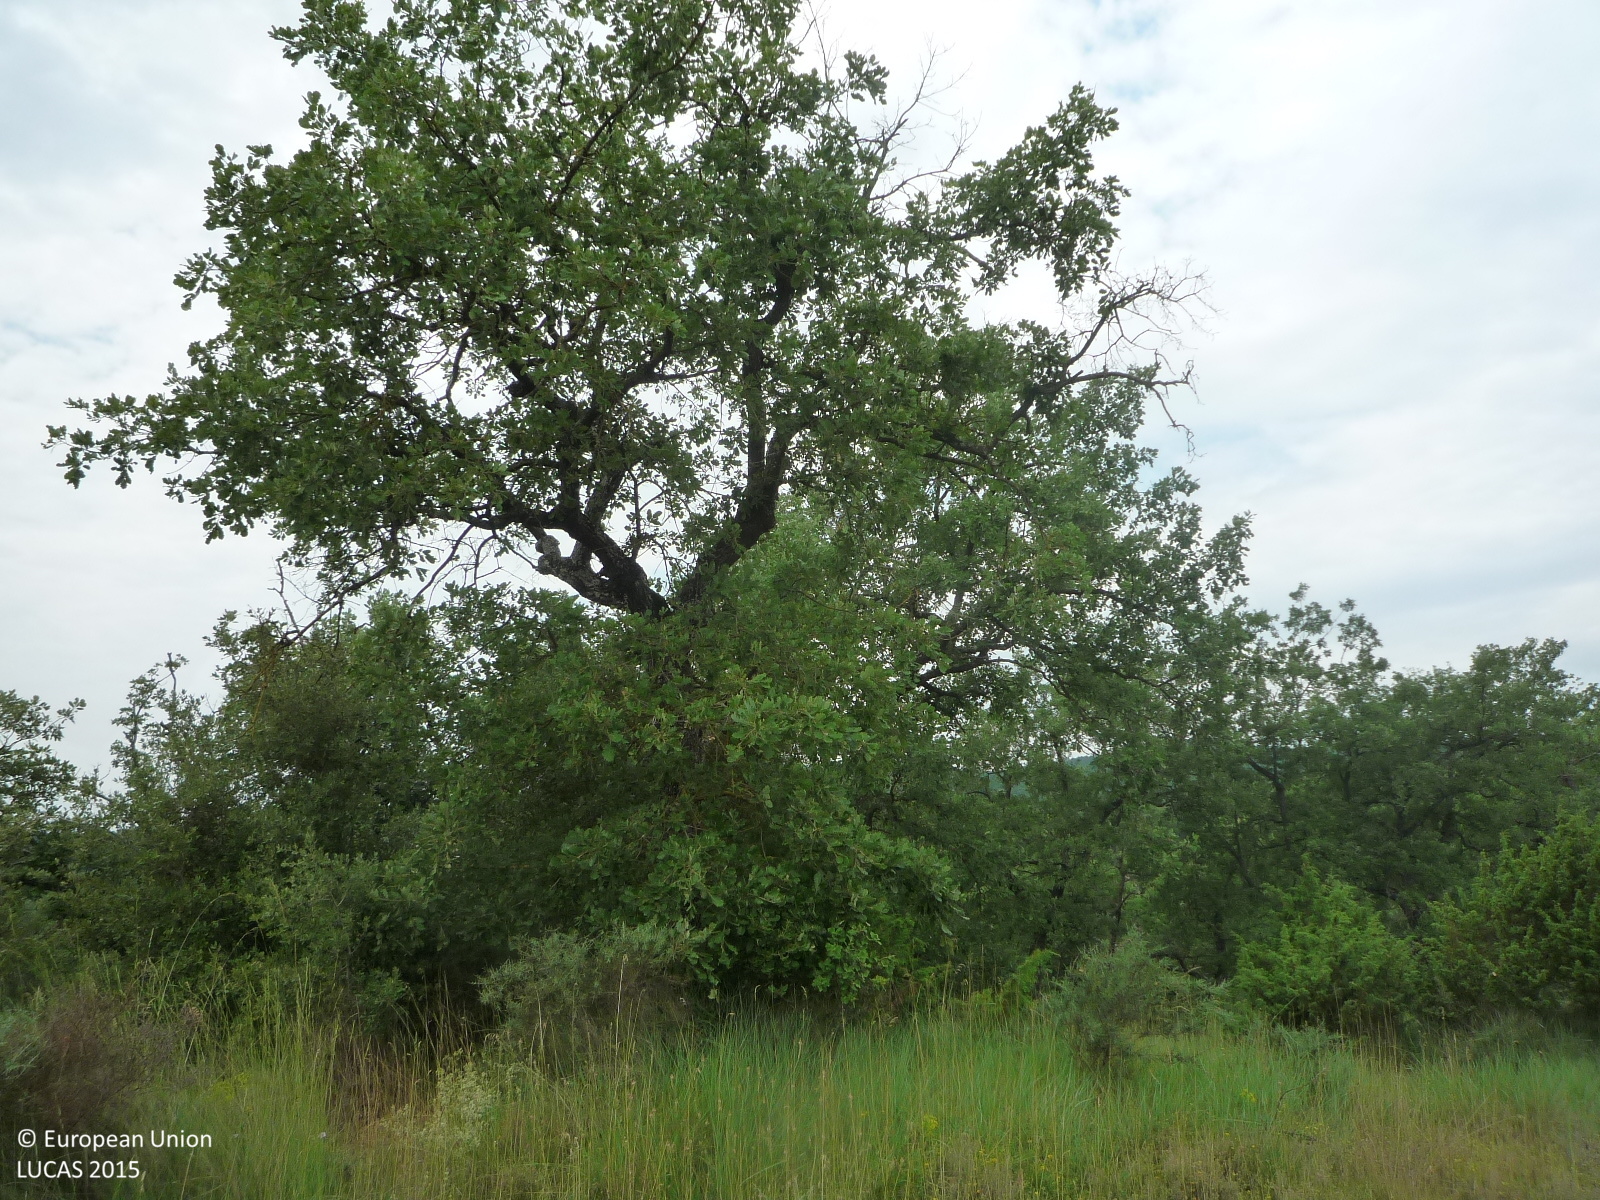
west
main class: Grassland
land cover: Grassland with sparse tree/shrub cover
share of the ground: > 75 %
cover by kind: herbaceous plants 95 %, broadleaved forest trees 5 %
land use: Agriculture (excluding fallow land and kitchen gardens)
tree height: < 5 m
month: June
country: ES
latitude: 41.9933
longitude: 2.0106
